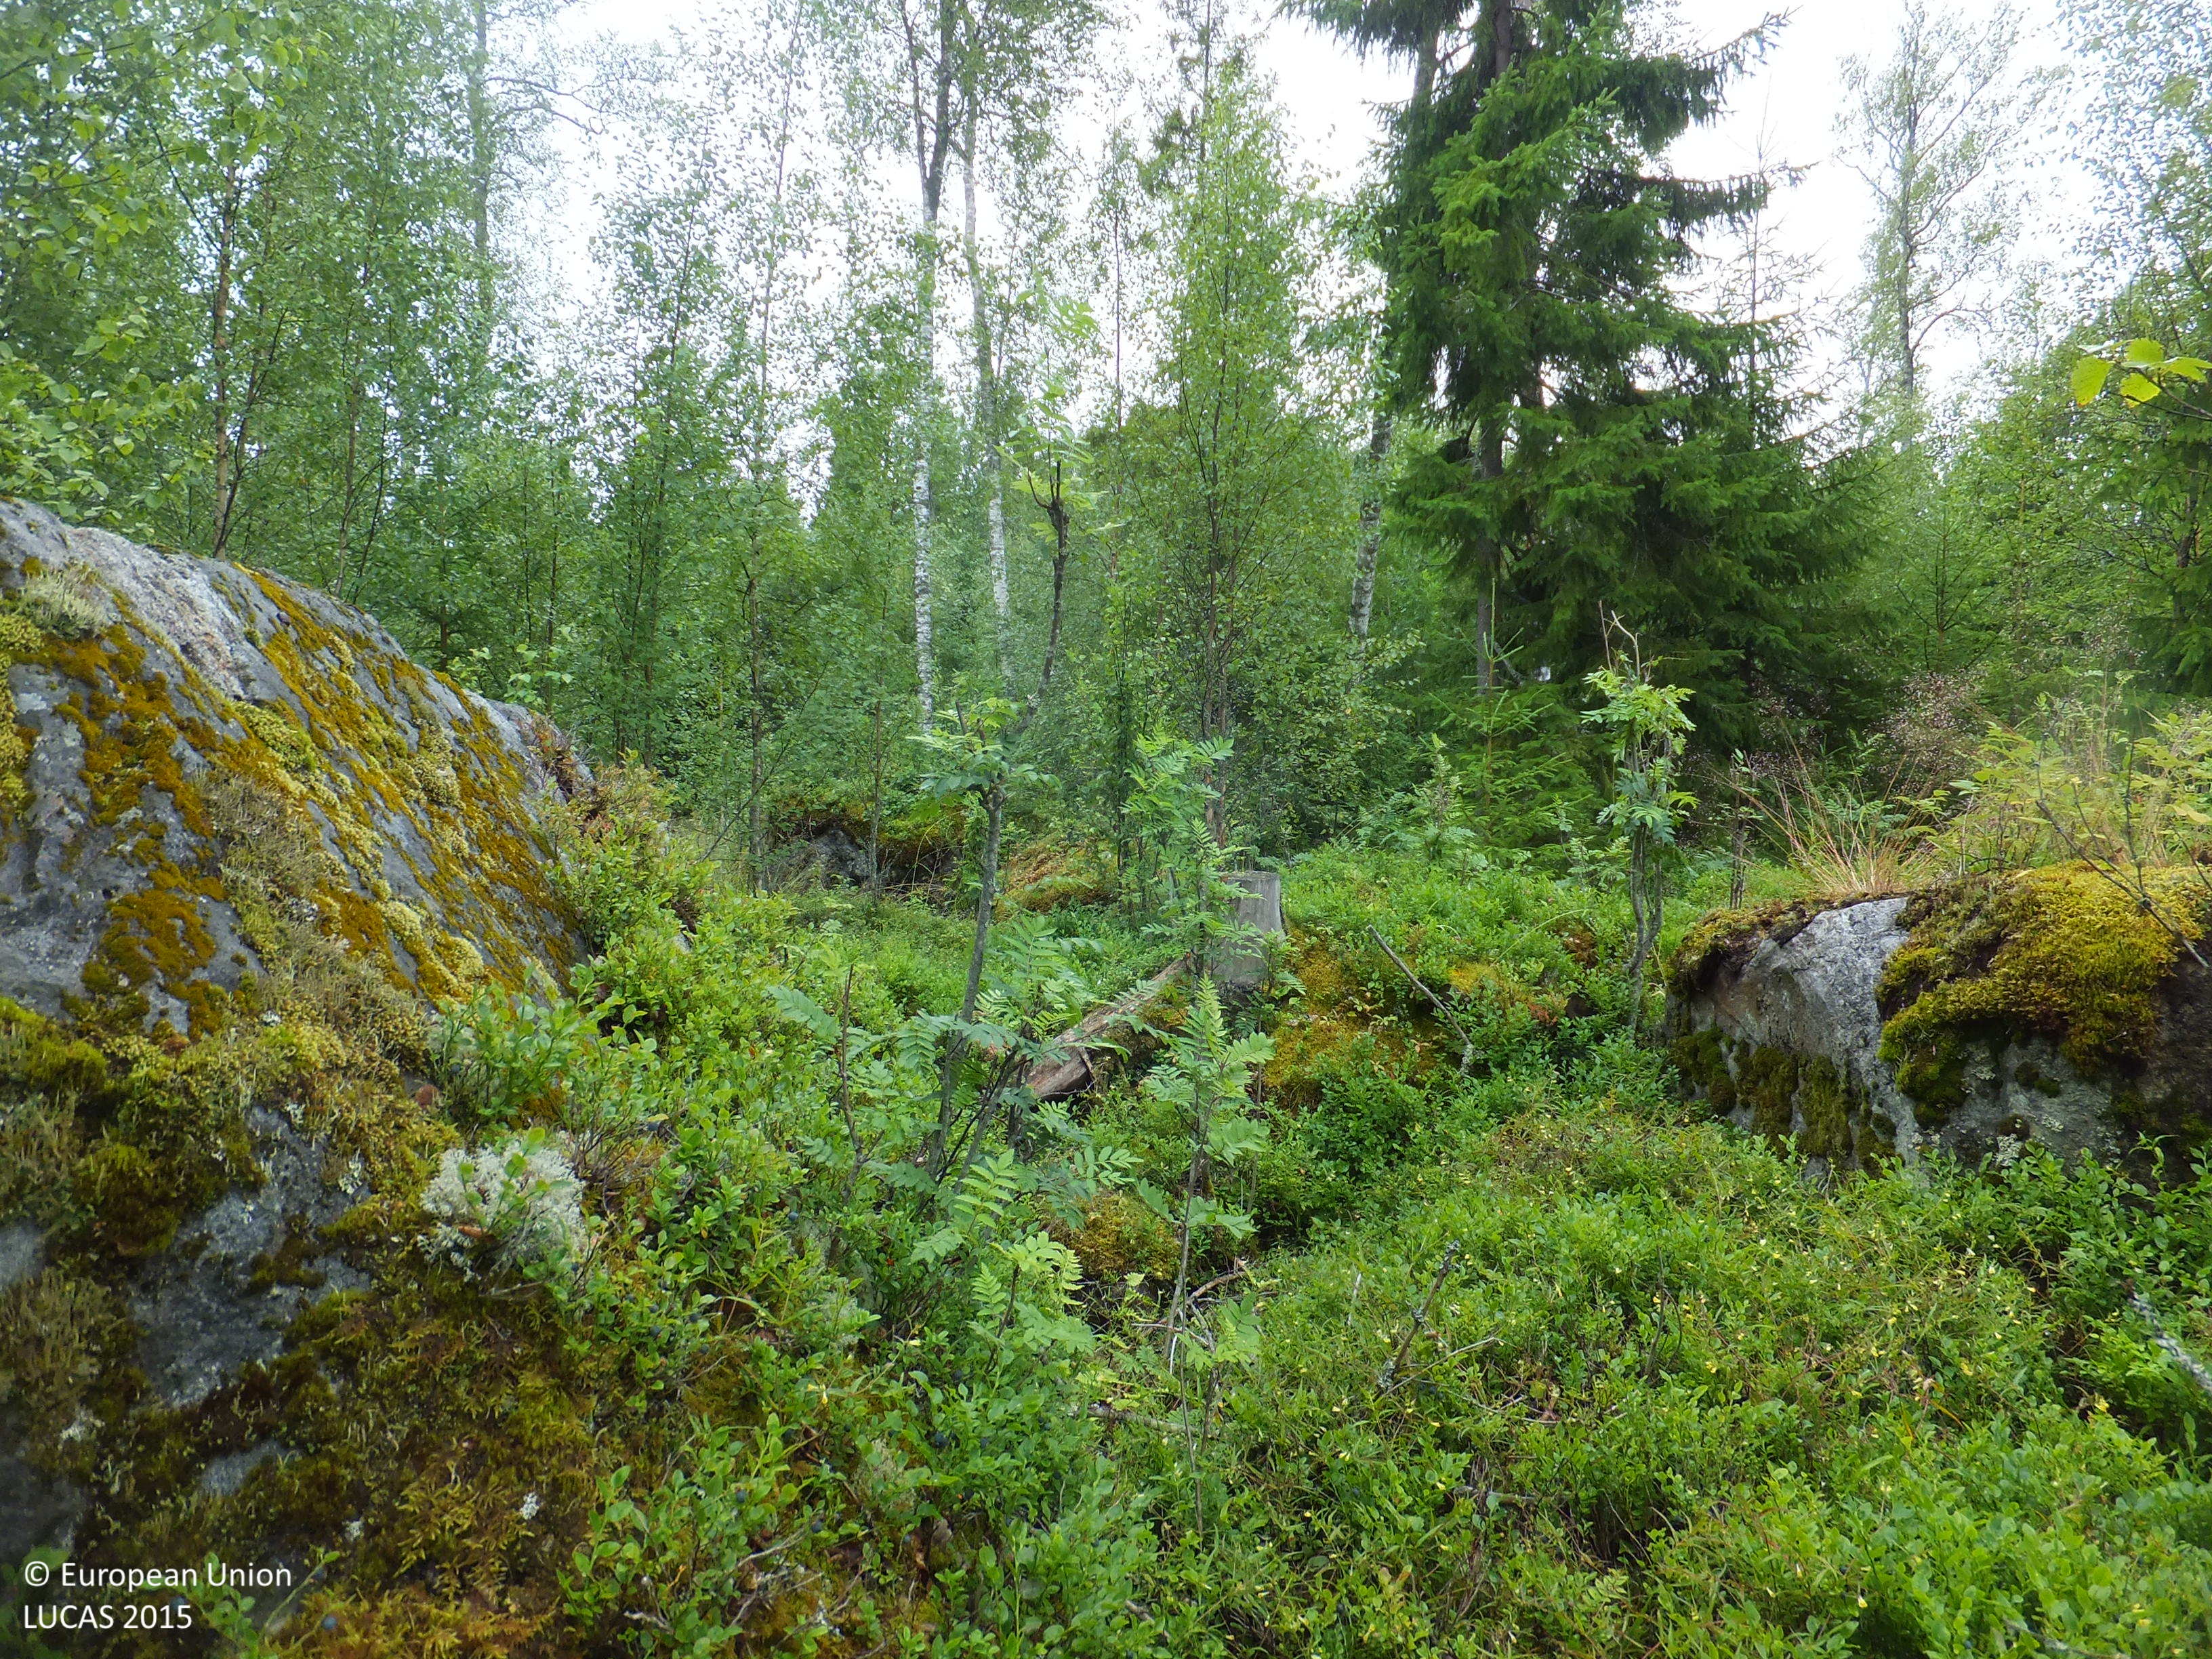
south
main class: Woodland
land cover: Spruce dominated mixed woodland
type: boreal forest
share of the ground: 25 - 50 %
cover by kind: shrubs 30 %, coniferous forest trees 25 %, broadleaved forest trees 20 %, lichens and mosses 10 %, consolidated bare surface 10 %, herbaceous plants 5 %
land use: Forestry
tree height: > 5 m
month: July
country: FI
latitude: 63.0562
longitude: 21.8527
